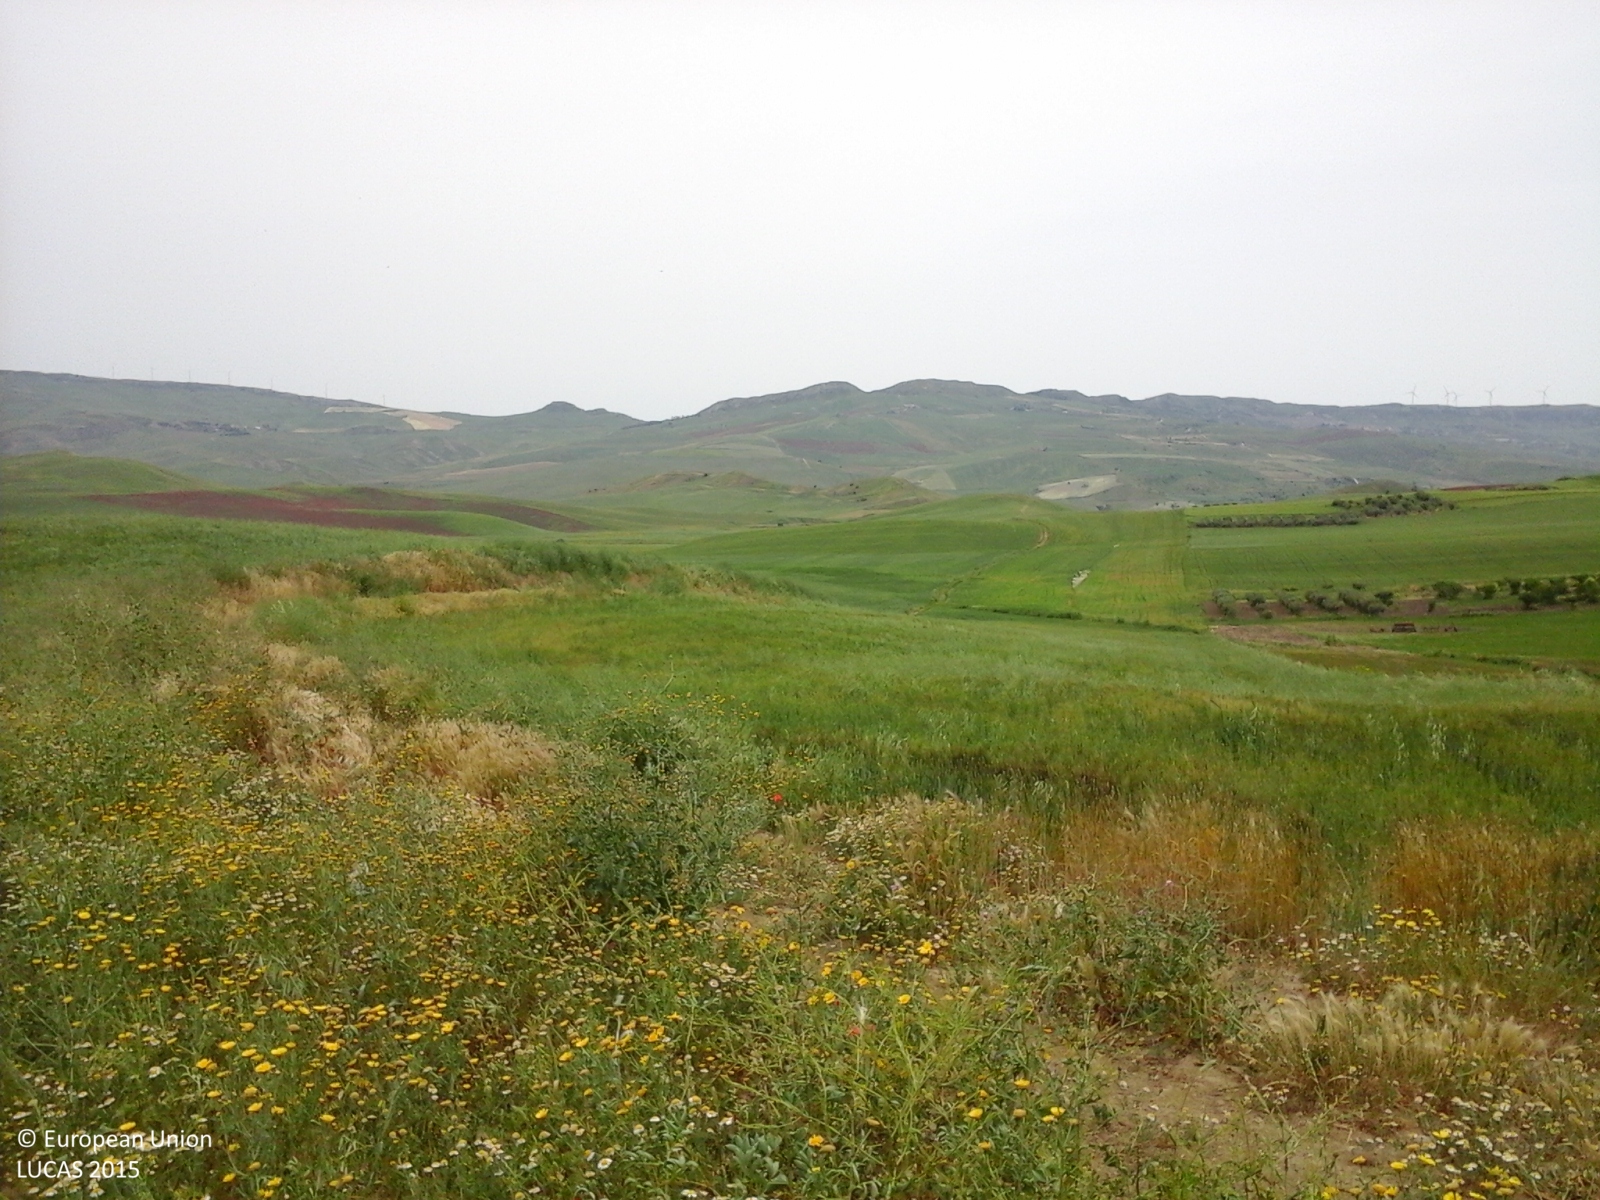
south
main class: Cropland
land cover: Dry pulses
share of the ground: > 75 %
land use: Agriculture (excluding fallow land and kitchen gardens)
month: May
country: IT
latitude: 37.6664
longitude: 13.9277
